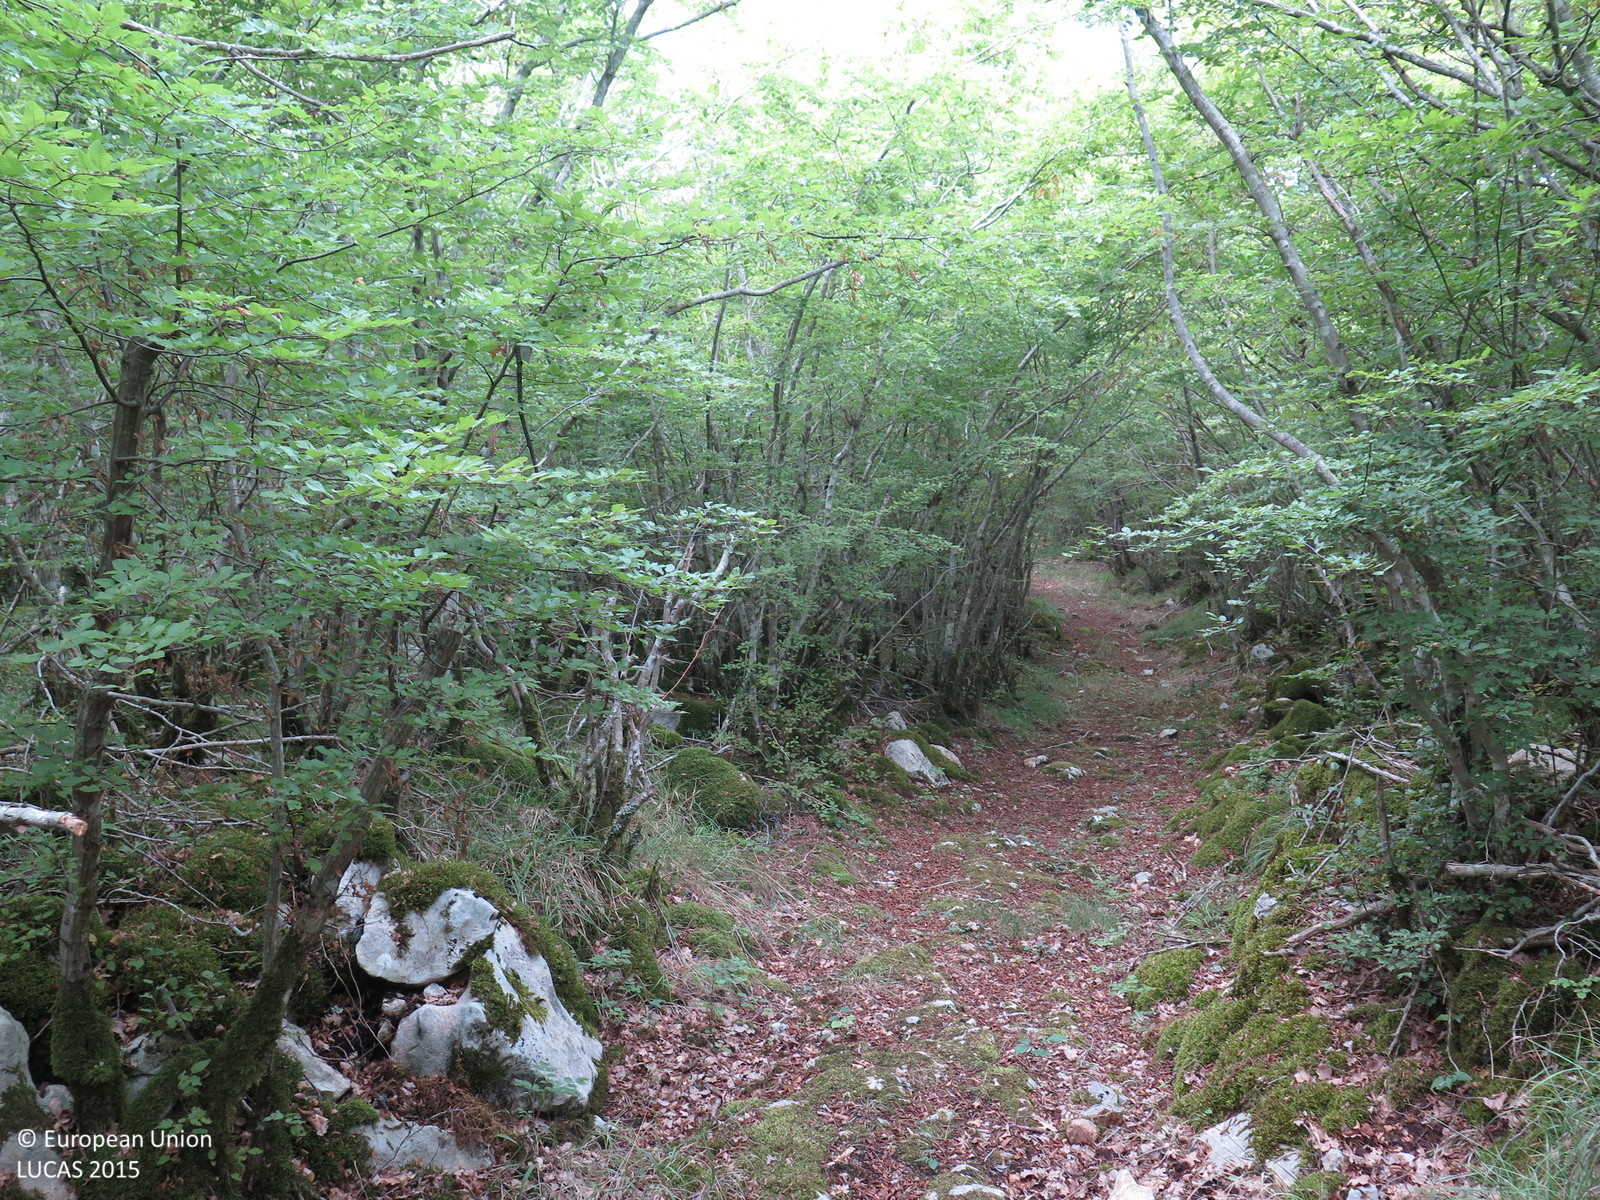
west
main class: Woodland
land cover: Broadleaved woodland
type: thermophilous deciduous forest
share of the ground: > 75 %
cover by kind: broadleaved forest trees 90 %, lichens and mosses 5 %, unconsolidated bare surface 5 %
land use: Semi-natural and natural areas not in use
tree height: < 5 m
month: August
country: HR
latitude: 45.1161
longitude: 14.5834
